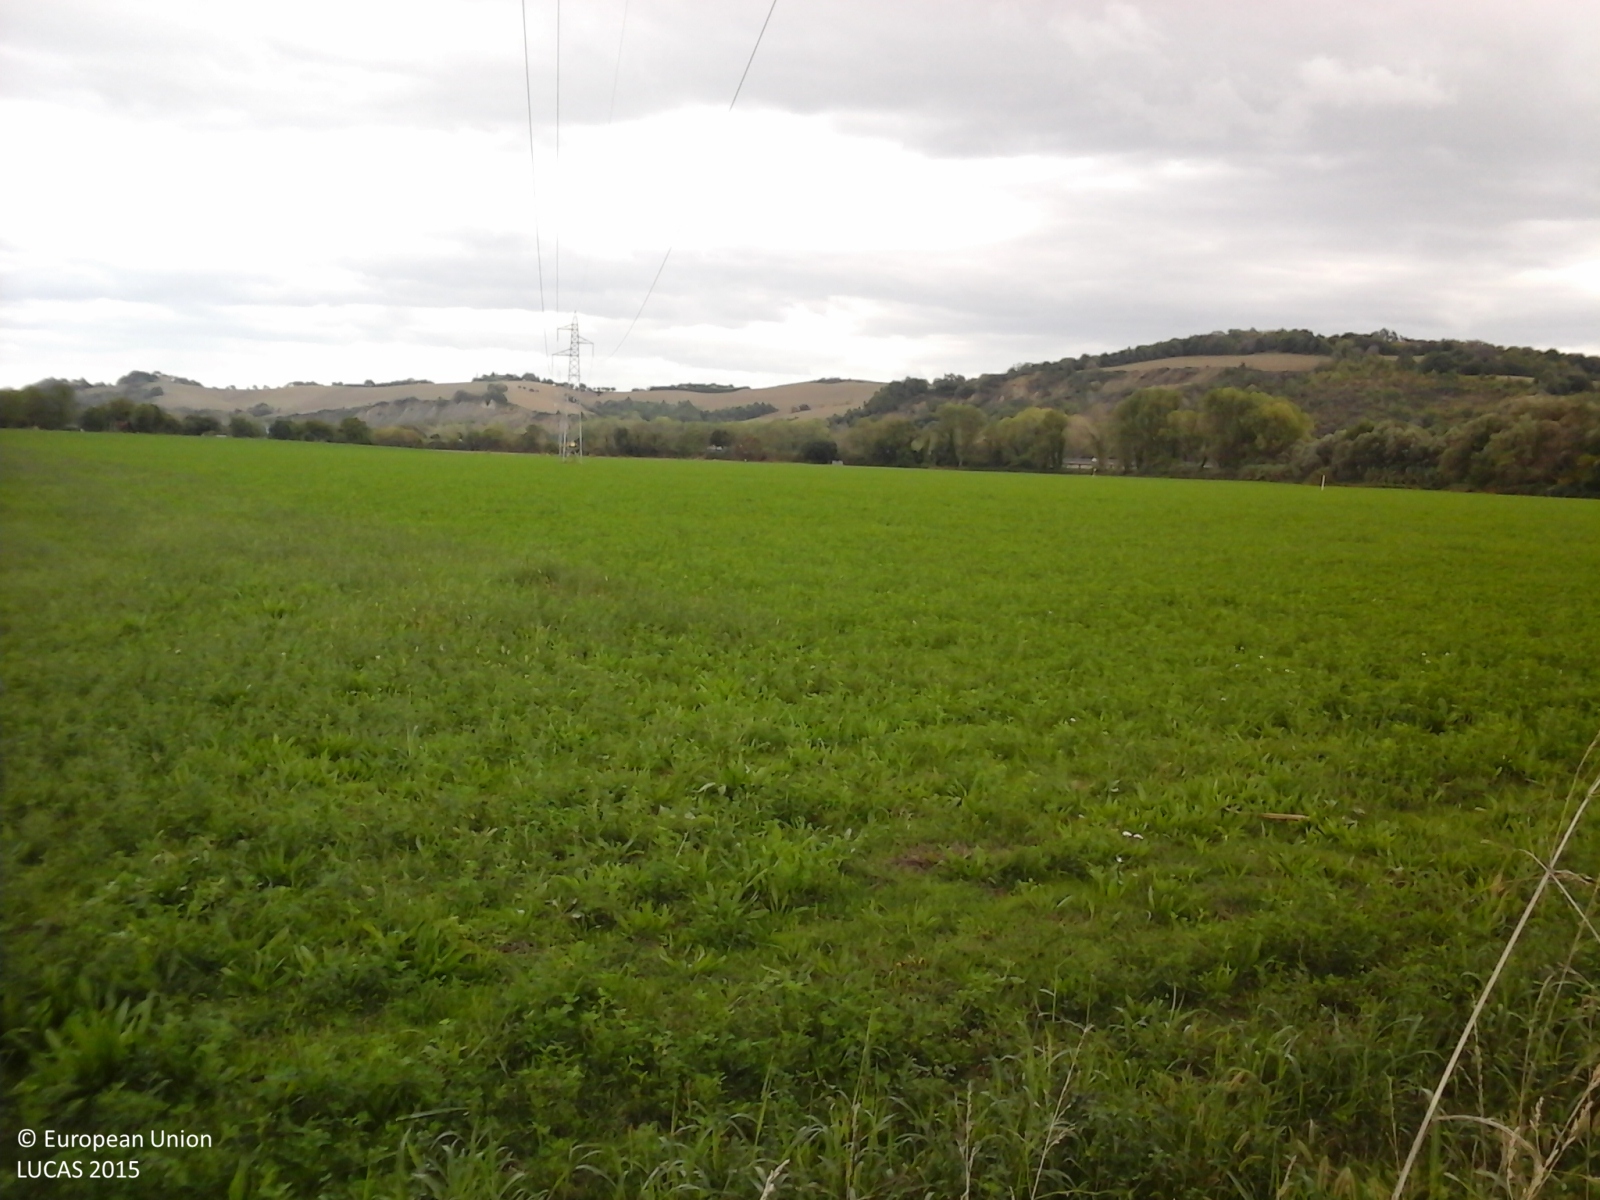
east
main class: Cropland
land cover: Lucerne
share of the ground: > 75 %
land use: Agriculture (excluding fallow land and kitchen gardens)
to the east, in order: Lucerne
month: October
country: IT
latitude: 43.5227
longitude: 13.2706
